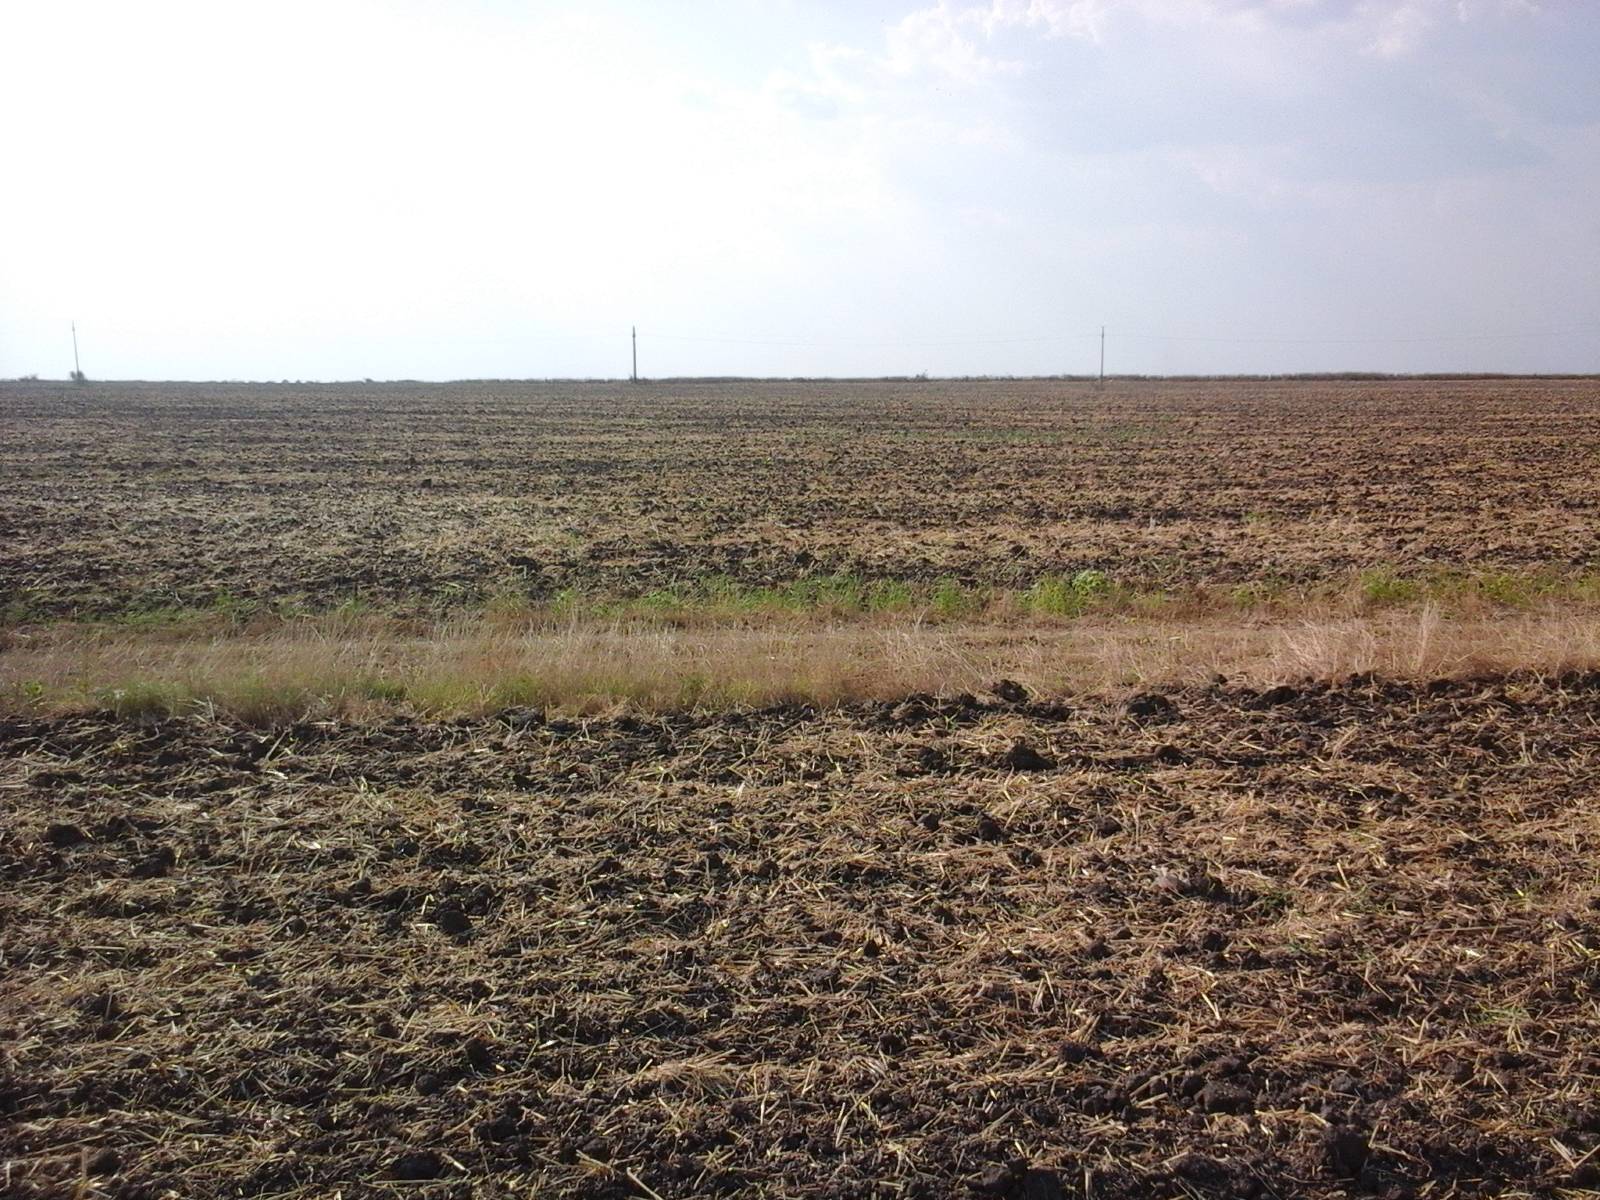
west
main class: Cropland
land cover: Common wheat
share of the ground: 10 - 25 %
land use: Agriculture (excluding fallow land and kitchen gardens)
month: August
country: RO
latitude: 43.9124
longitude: 23.5603
